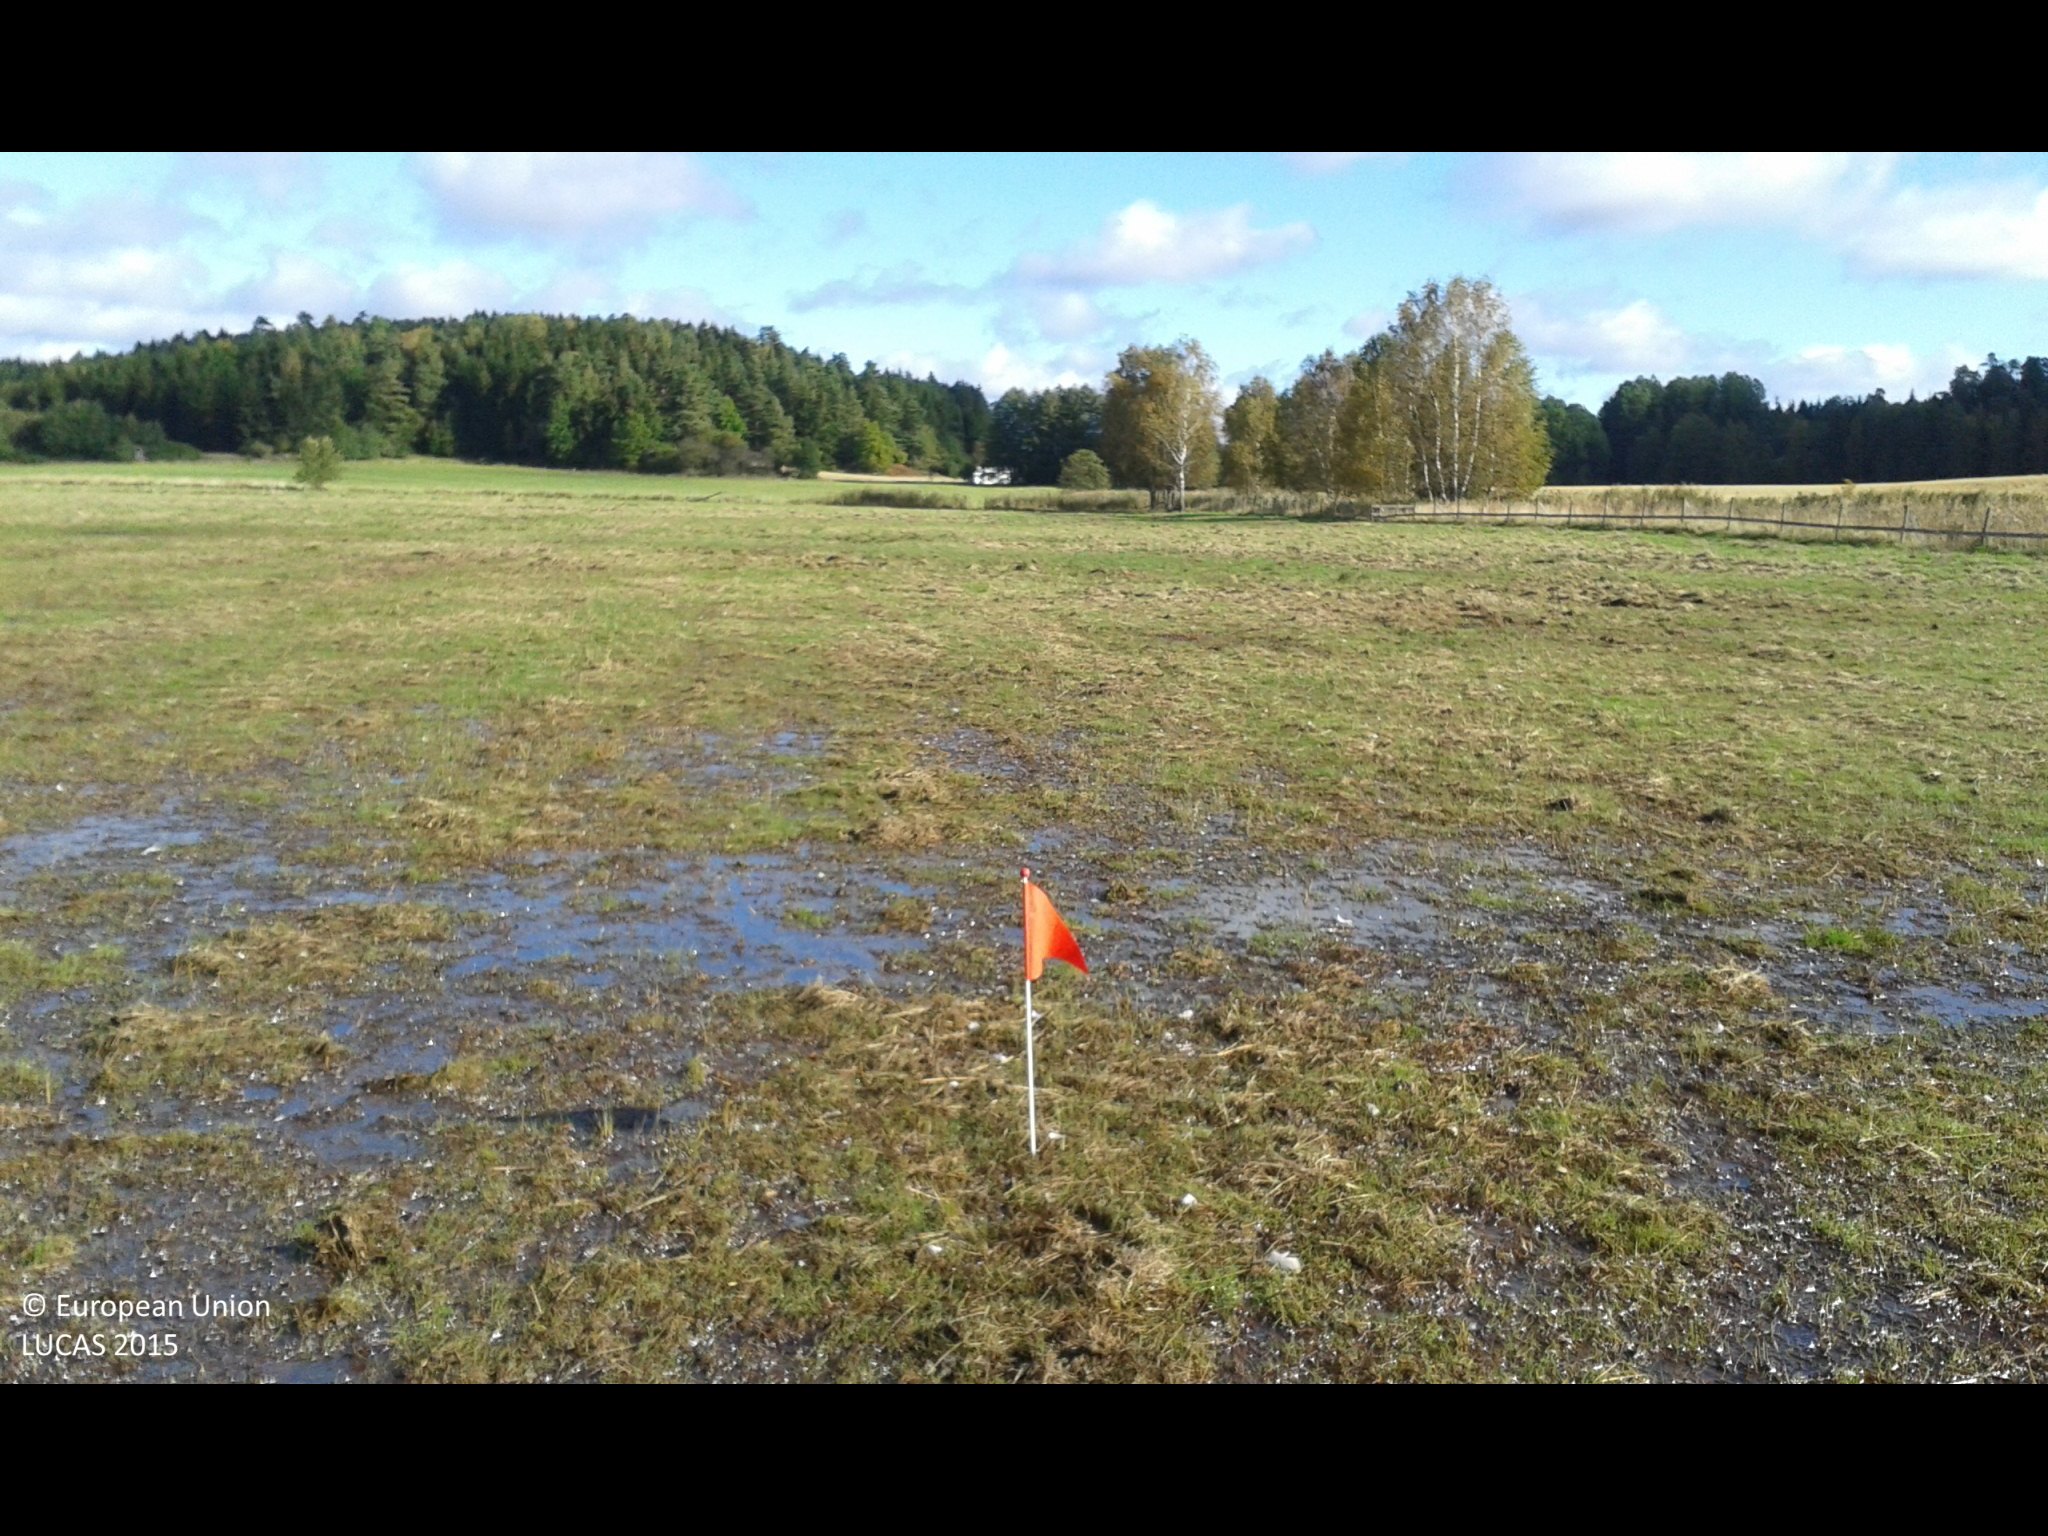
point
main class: Grassland
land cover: Grassland without tree/shrub cover
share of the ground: > 75 %
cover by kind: herbaceous plants 100 %
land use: Agriculture (excluding fallow land and kitchen gardens)
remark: Temporary flooded
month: September
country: SE
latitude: 58.9628
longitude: 17.5969
